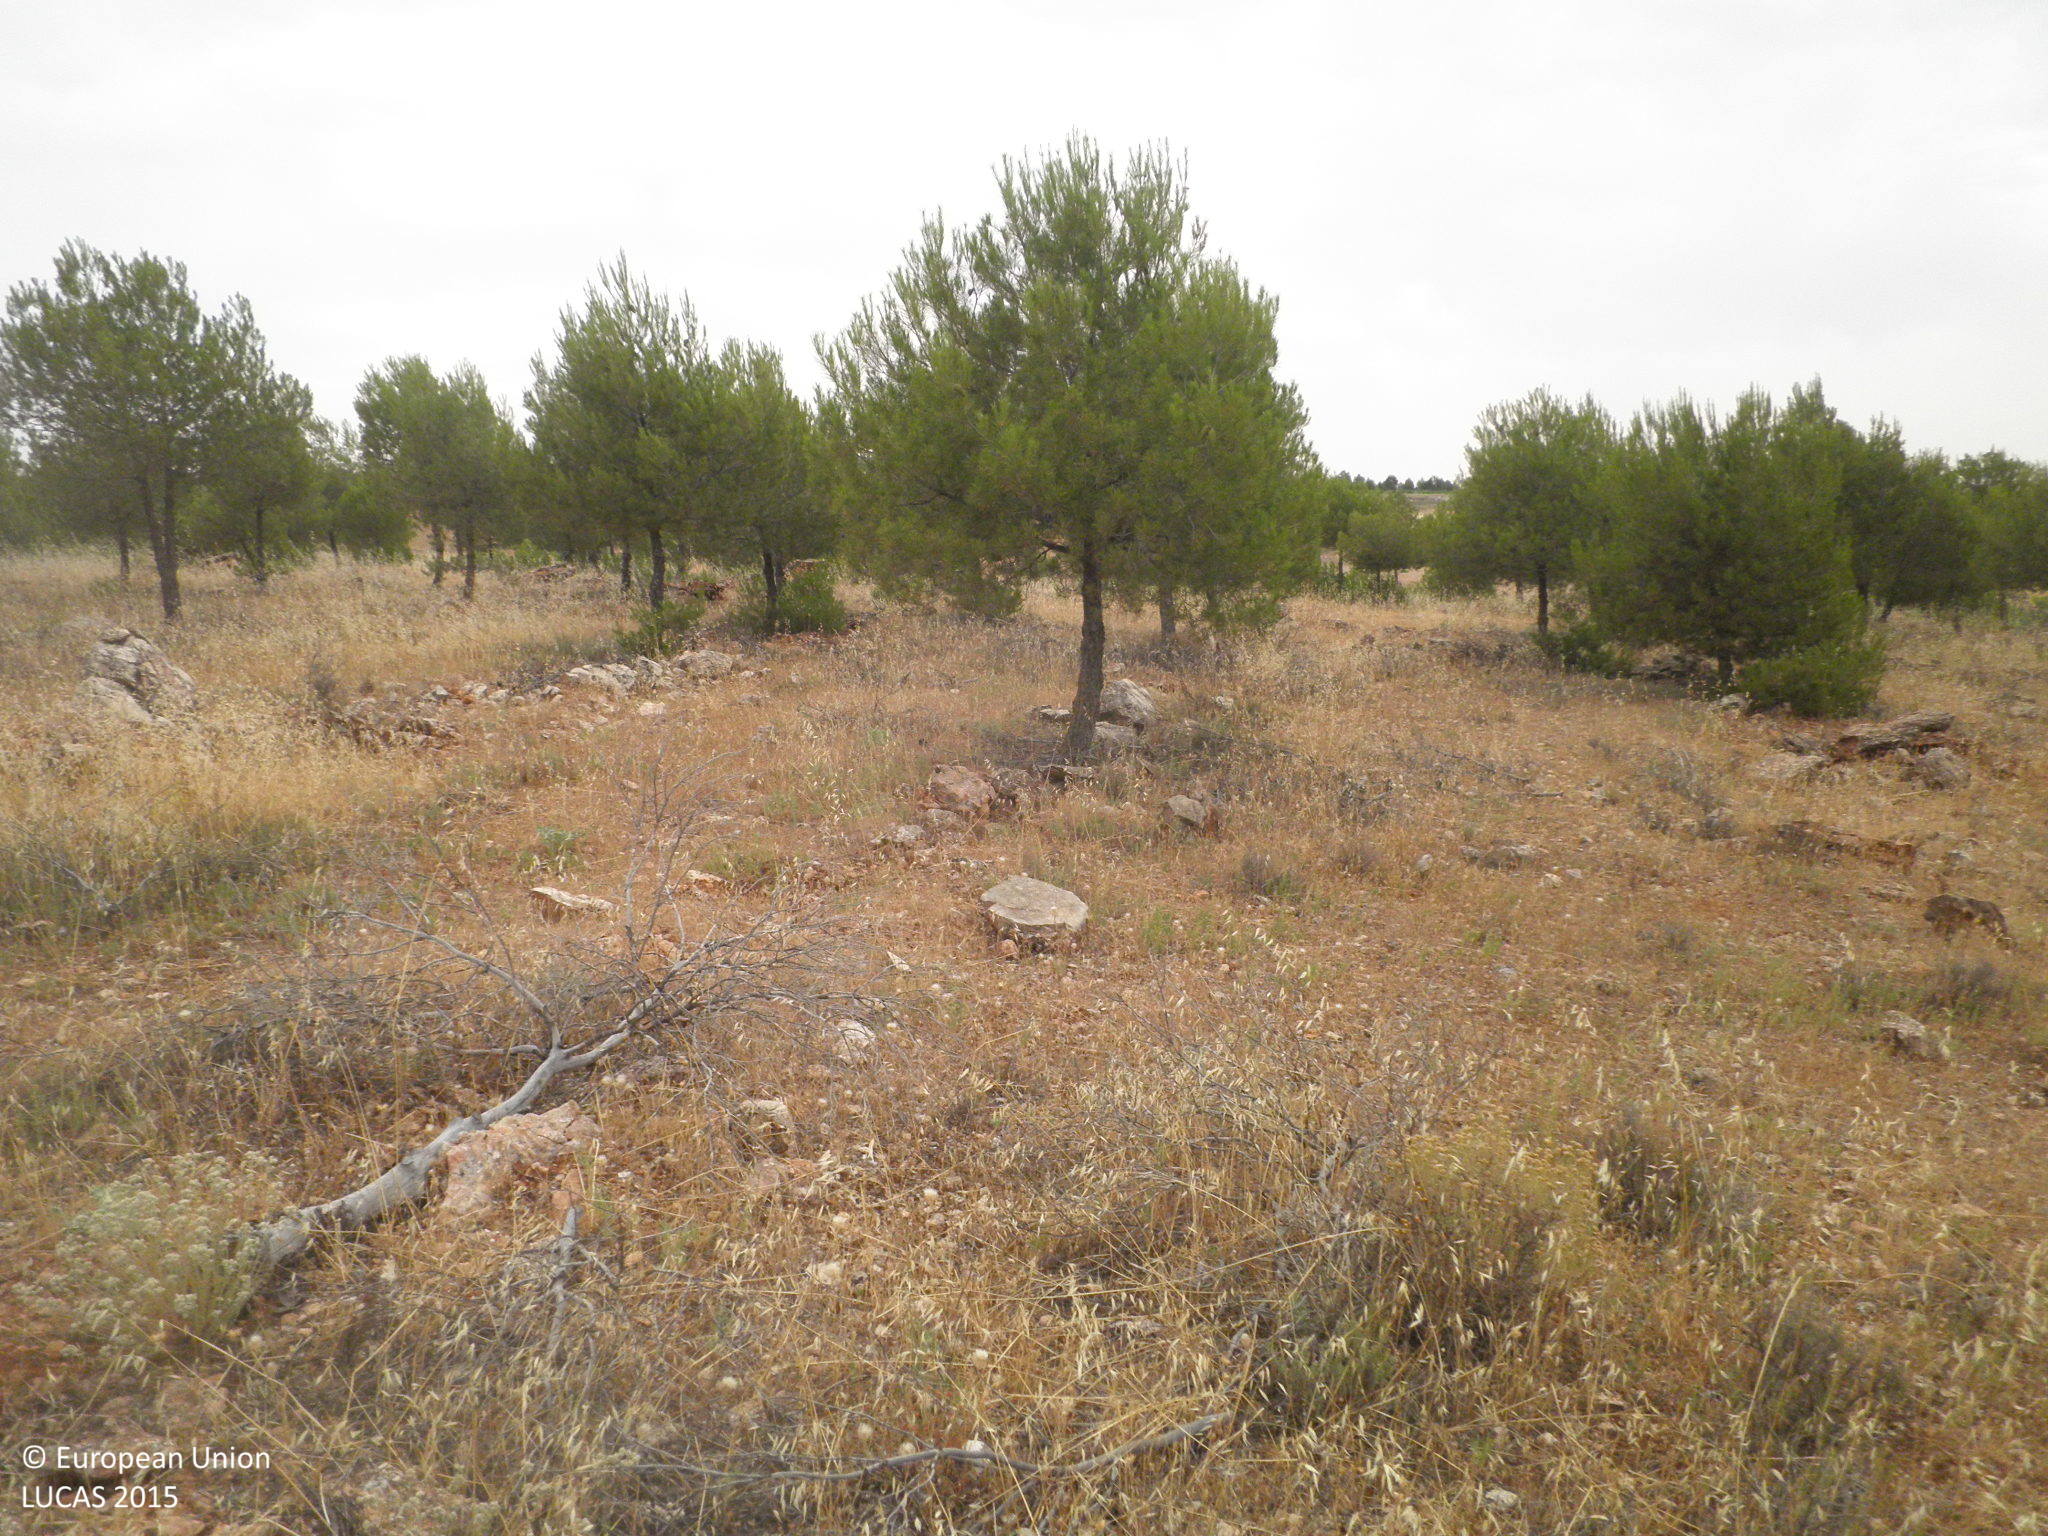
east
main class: Woodland
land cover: Pine dominated coniferous woodland
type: coniferous forest of the mediterranean region
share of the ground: 10 - 25 %
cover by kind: herbaceous plants 75 %, coniferous forest trees 10 %, consolidated bare surface 10 %, shrubs 5 %
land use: Semi-natural and natural areas not in use
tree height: < 5 m
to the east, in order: Pine dominated coniferous woodland; Tracks; Grassland without tree/shrub cover; Olive groves; Grassland without tree/shrub cover; Vineyards; Shrubland without tree cover; Dry stone walls; Vineyards; Grass margins; Dry stone walls; Vineyards; Grass margins; Dry stone walls; Grass margins; Dry pulses; Grass margins; Dry pulses
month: July
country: ES
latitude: 39.4784
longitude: -2.6735
